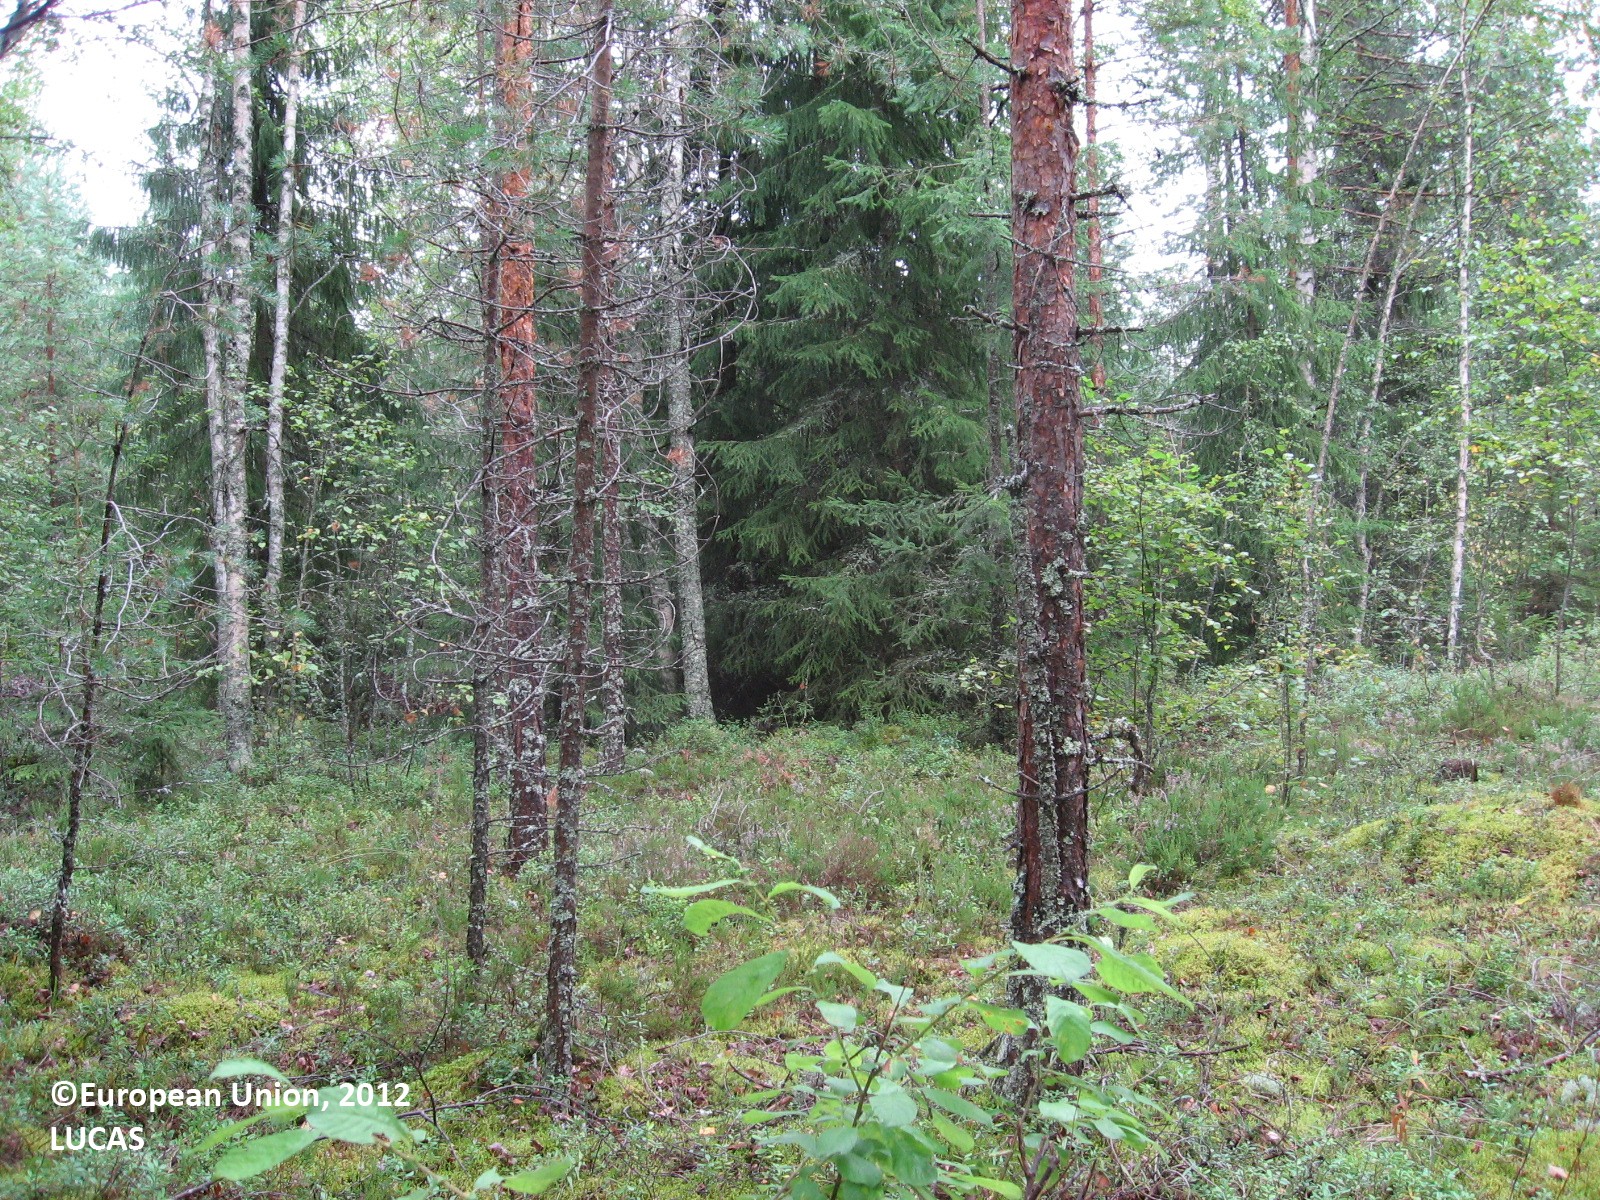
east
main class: Woodland
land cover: Spruce dominated mixed woodland
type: boreal forest
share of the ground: > 75 %
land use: Forestry
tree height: > 5 m
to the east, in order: Spruce dominated mixed woodland; Ditches and canals; Spruce dominated mixed woodland; Pine dominated mixed woodland; Spruce dominated mixed woodland; Tracks; Spruce dominated mixed woodland; Tracks; Pine dominated coniferous woodland
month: August
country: FI
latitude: 61.1080
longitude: 24.7460
